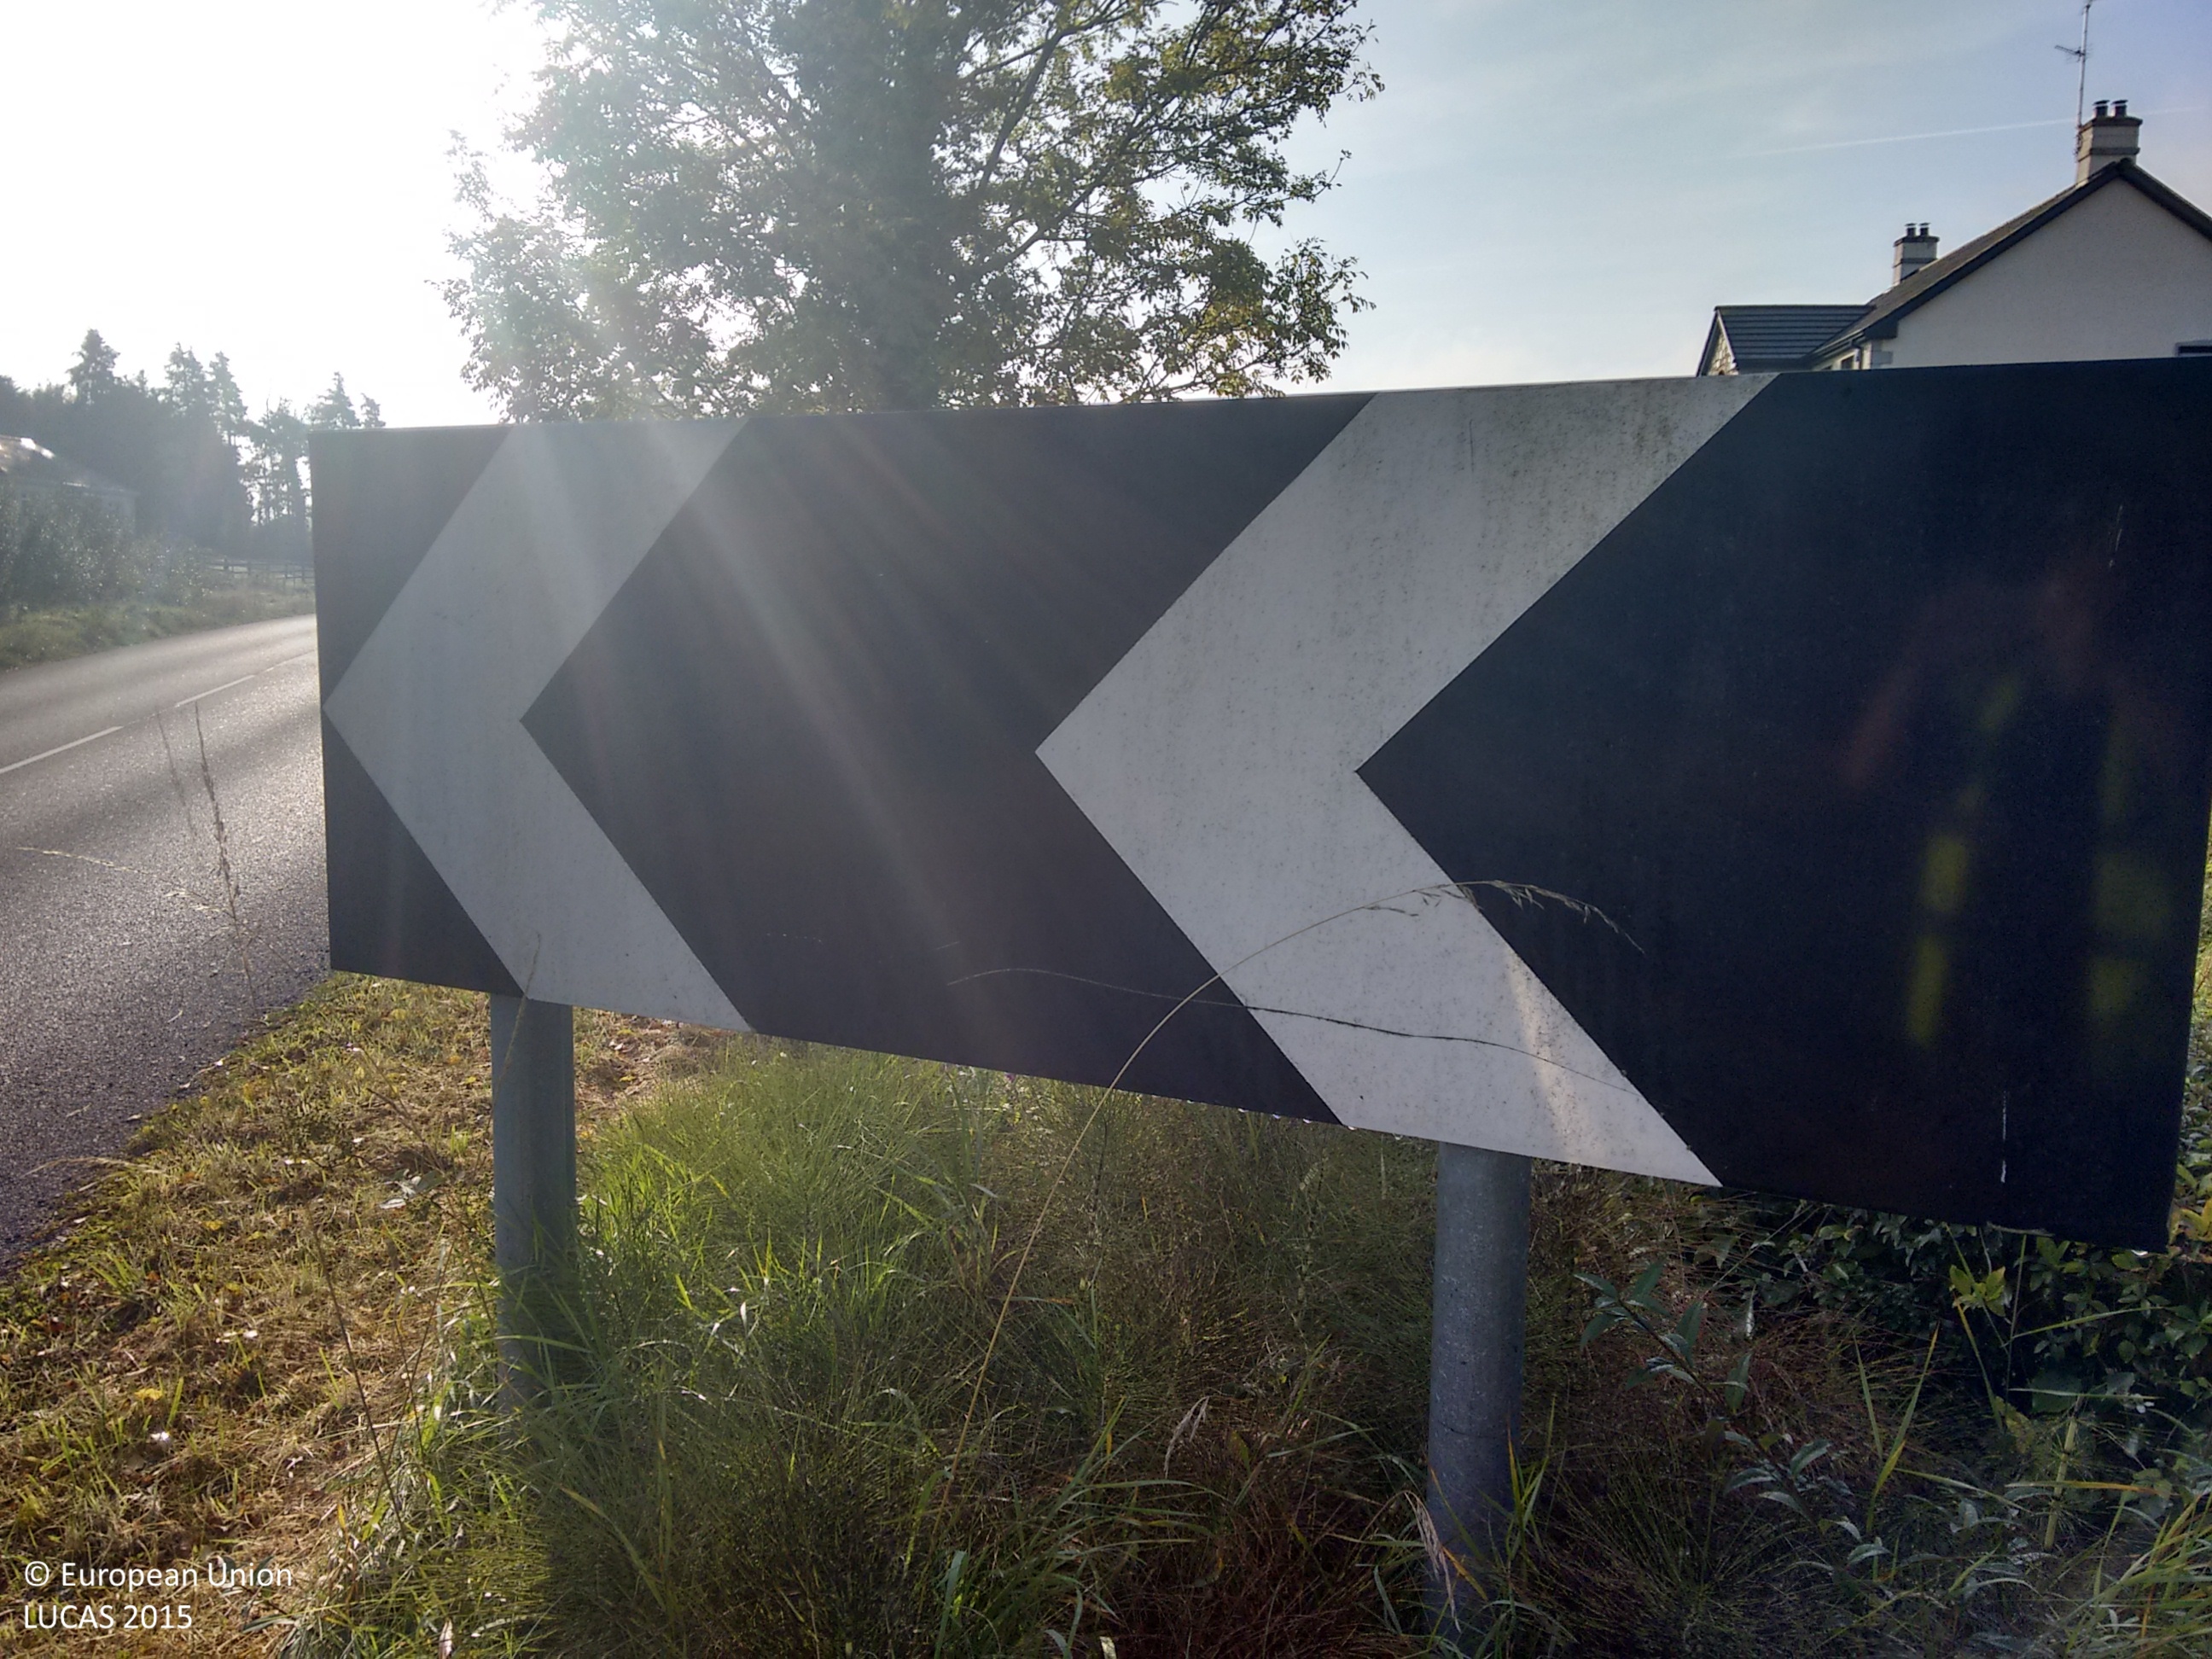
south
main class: Grassland
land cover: Grassland without tree/shrub cover
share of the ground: > 75 %
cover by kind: herbaceous plants 100 %
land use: Residential
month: October
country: GB
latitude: 54.2401
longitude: -7.7016
